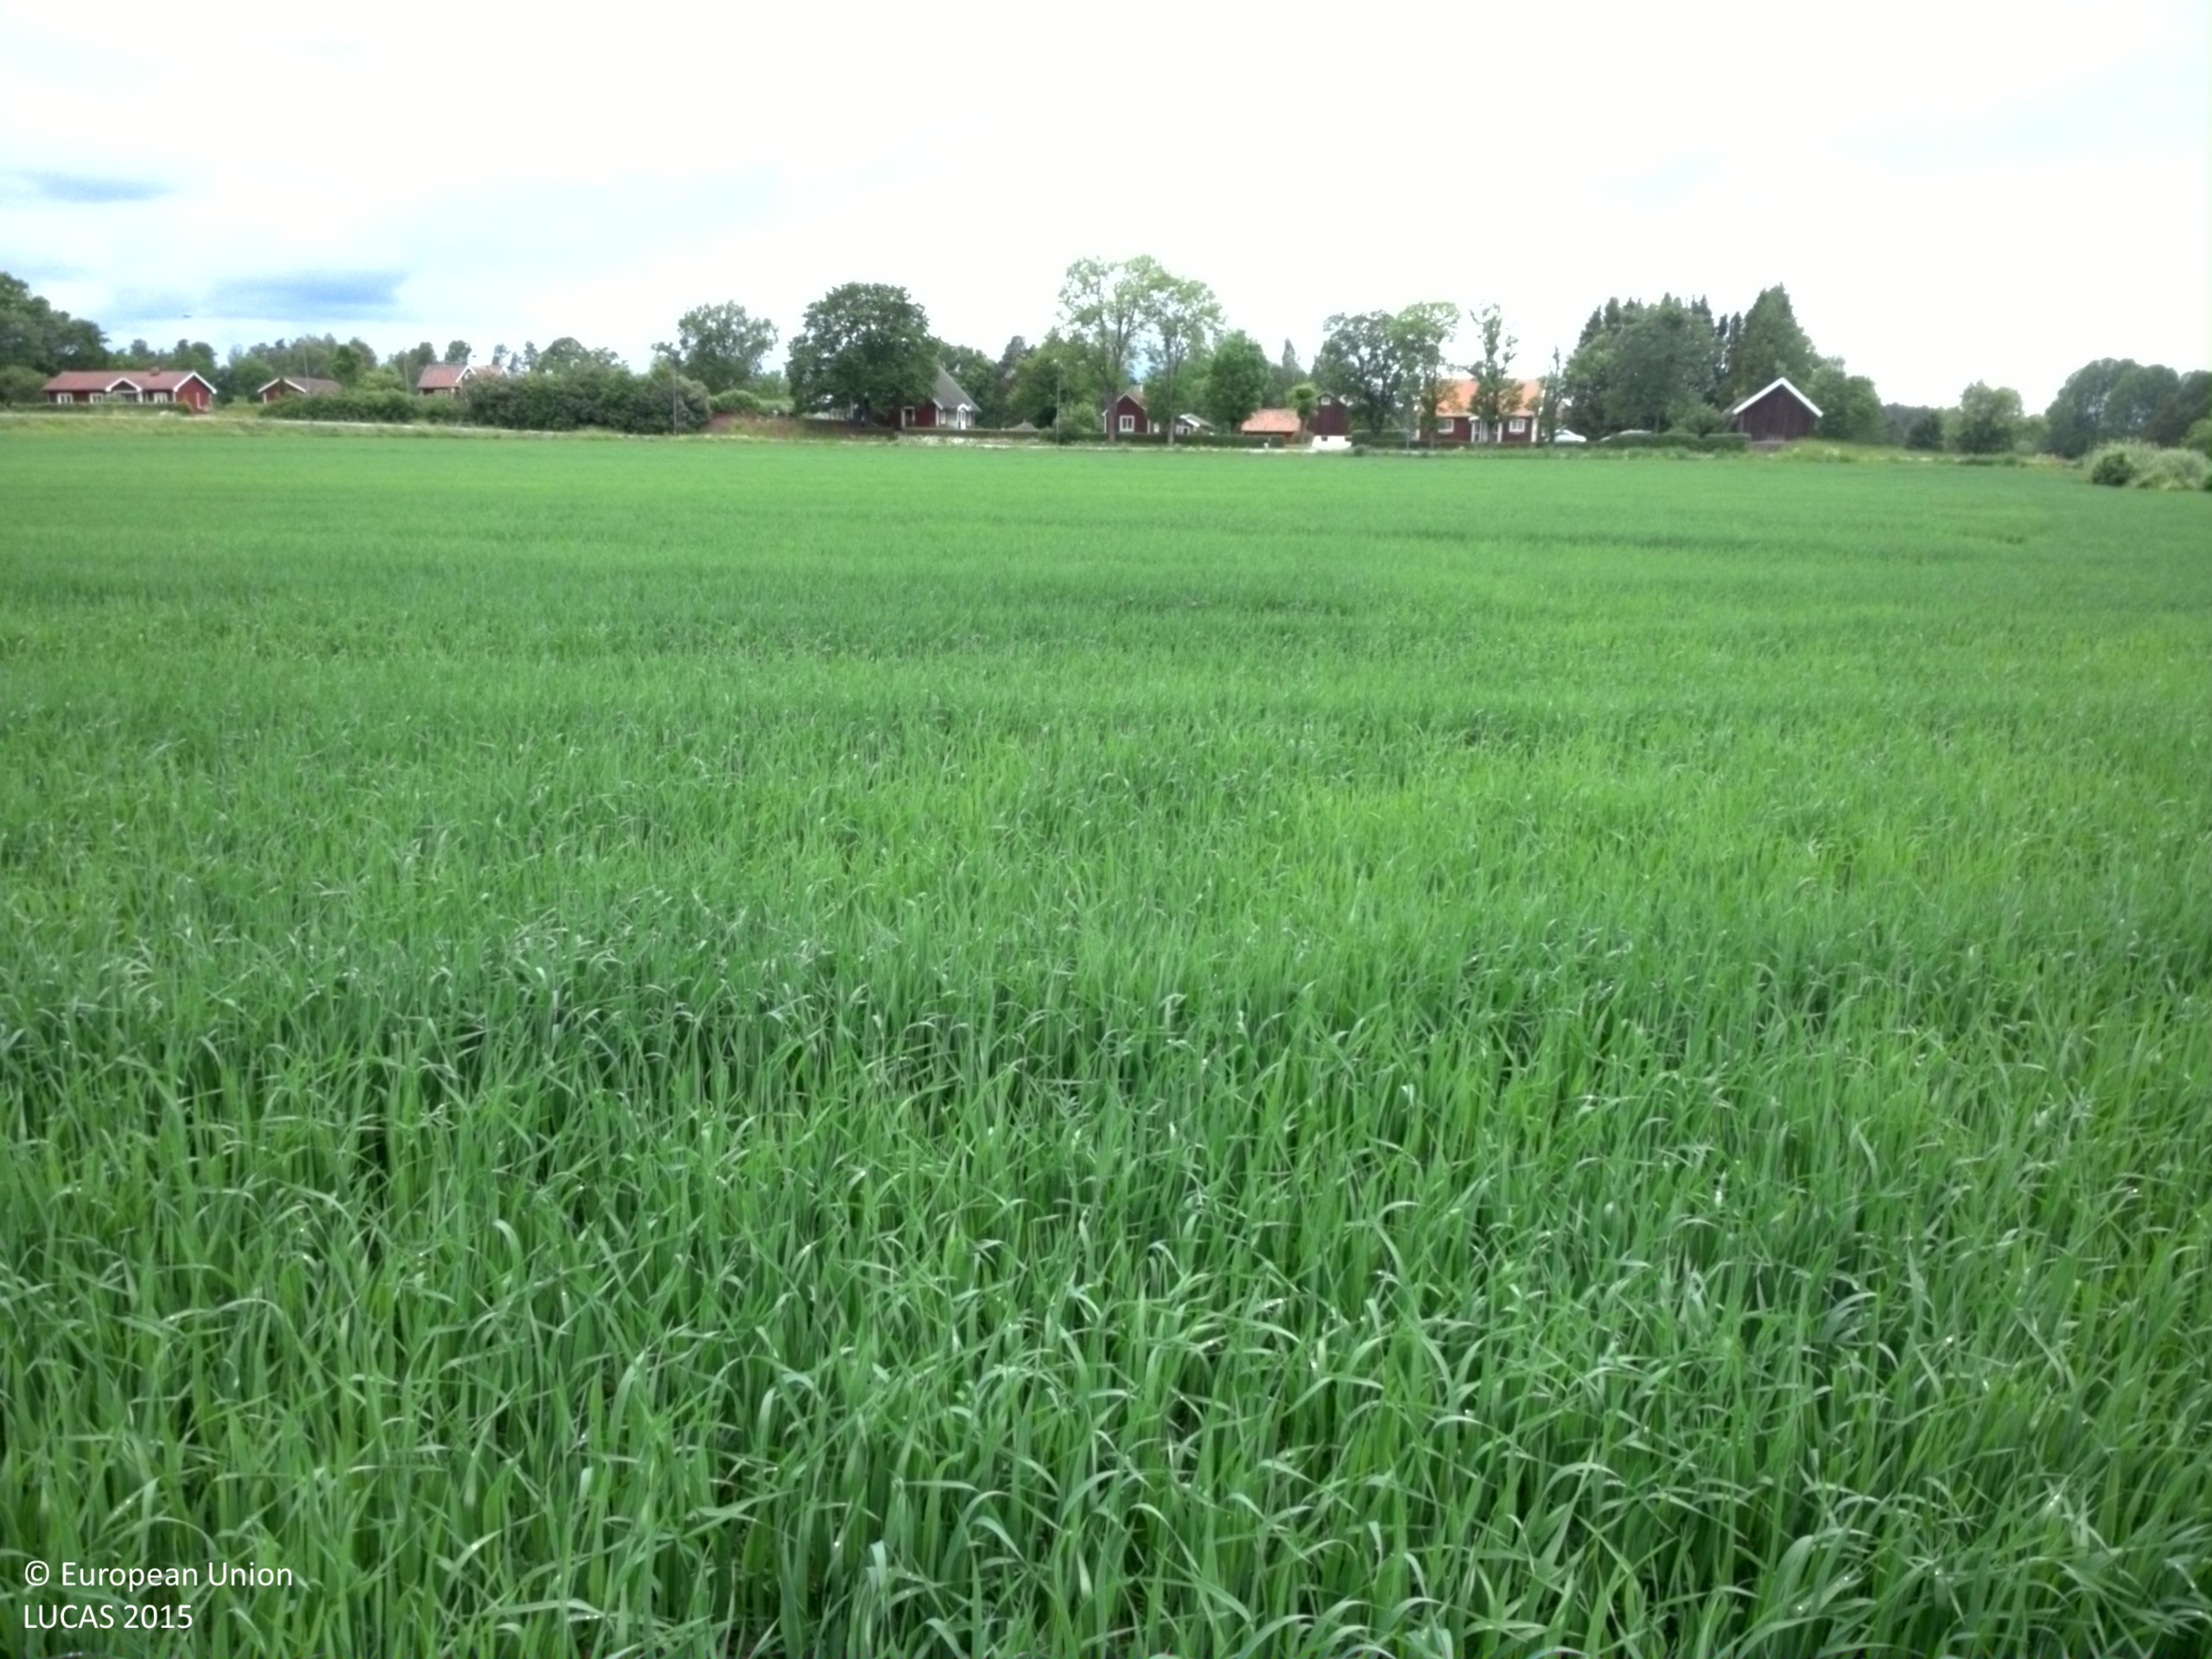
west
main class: Cropland
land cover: Oats
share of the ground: > 75 %
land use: Agriculture (excluding fallow land and kitchen gardens)
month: June
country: SE
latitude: 60.1737
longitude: 17.6173
